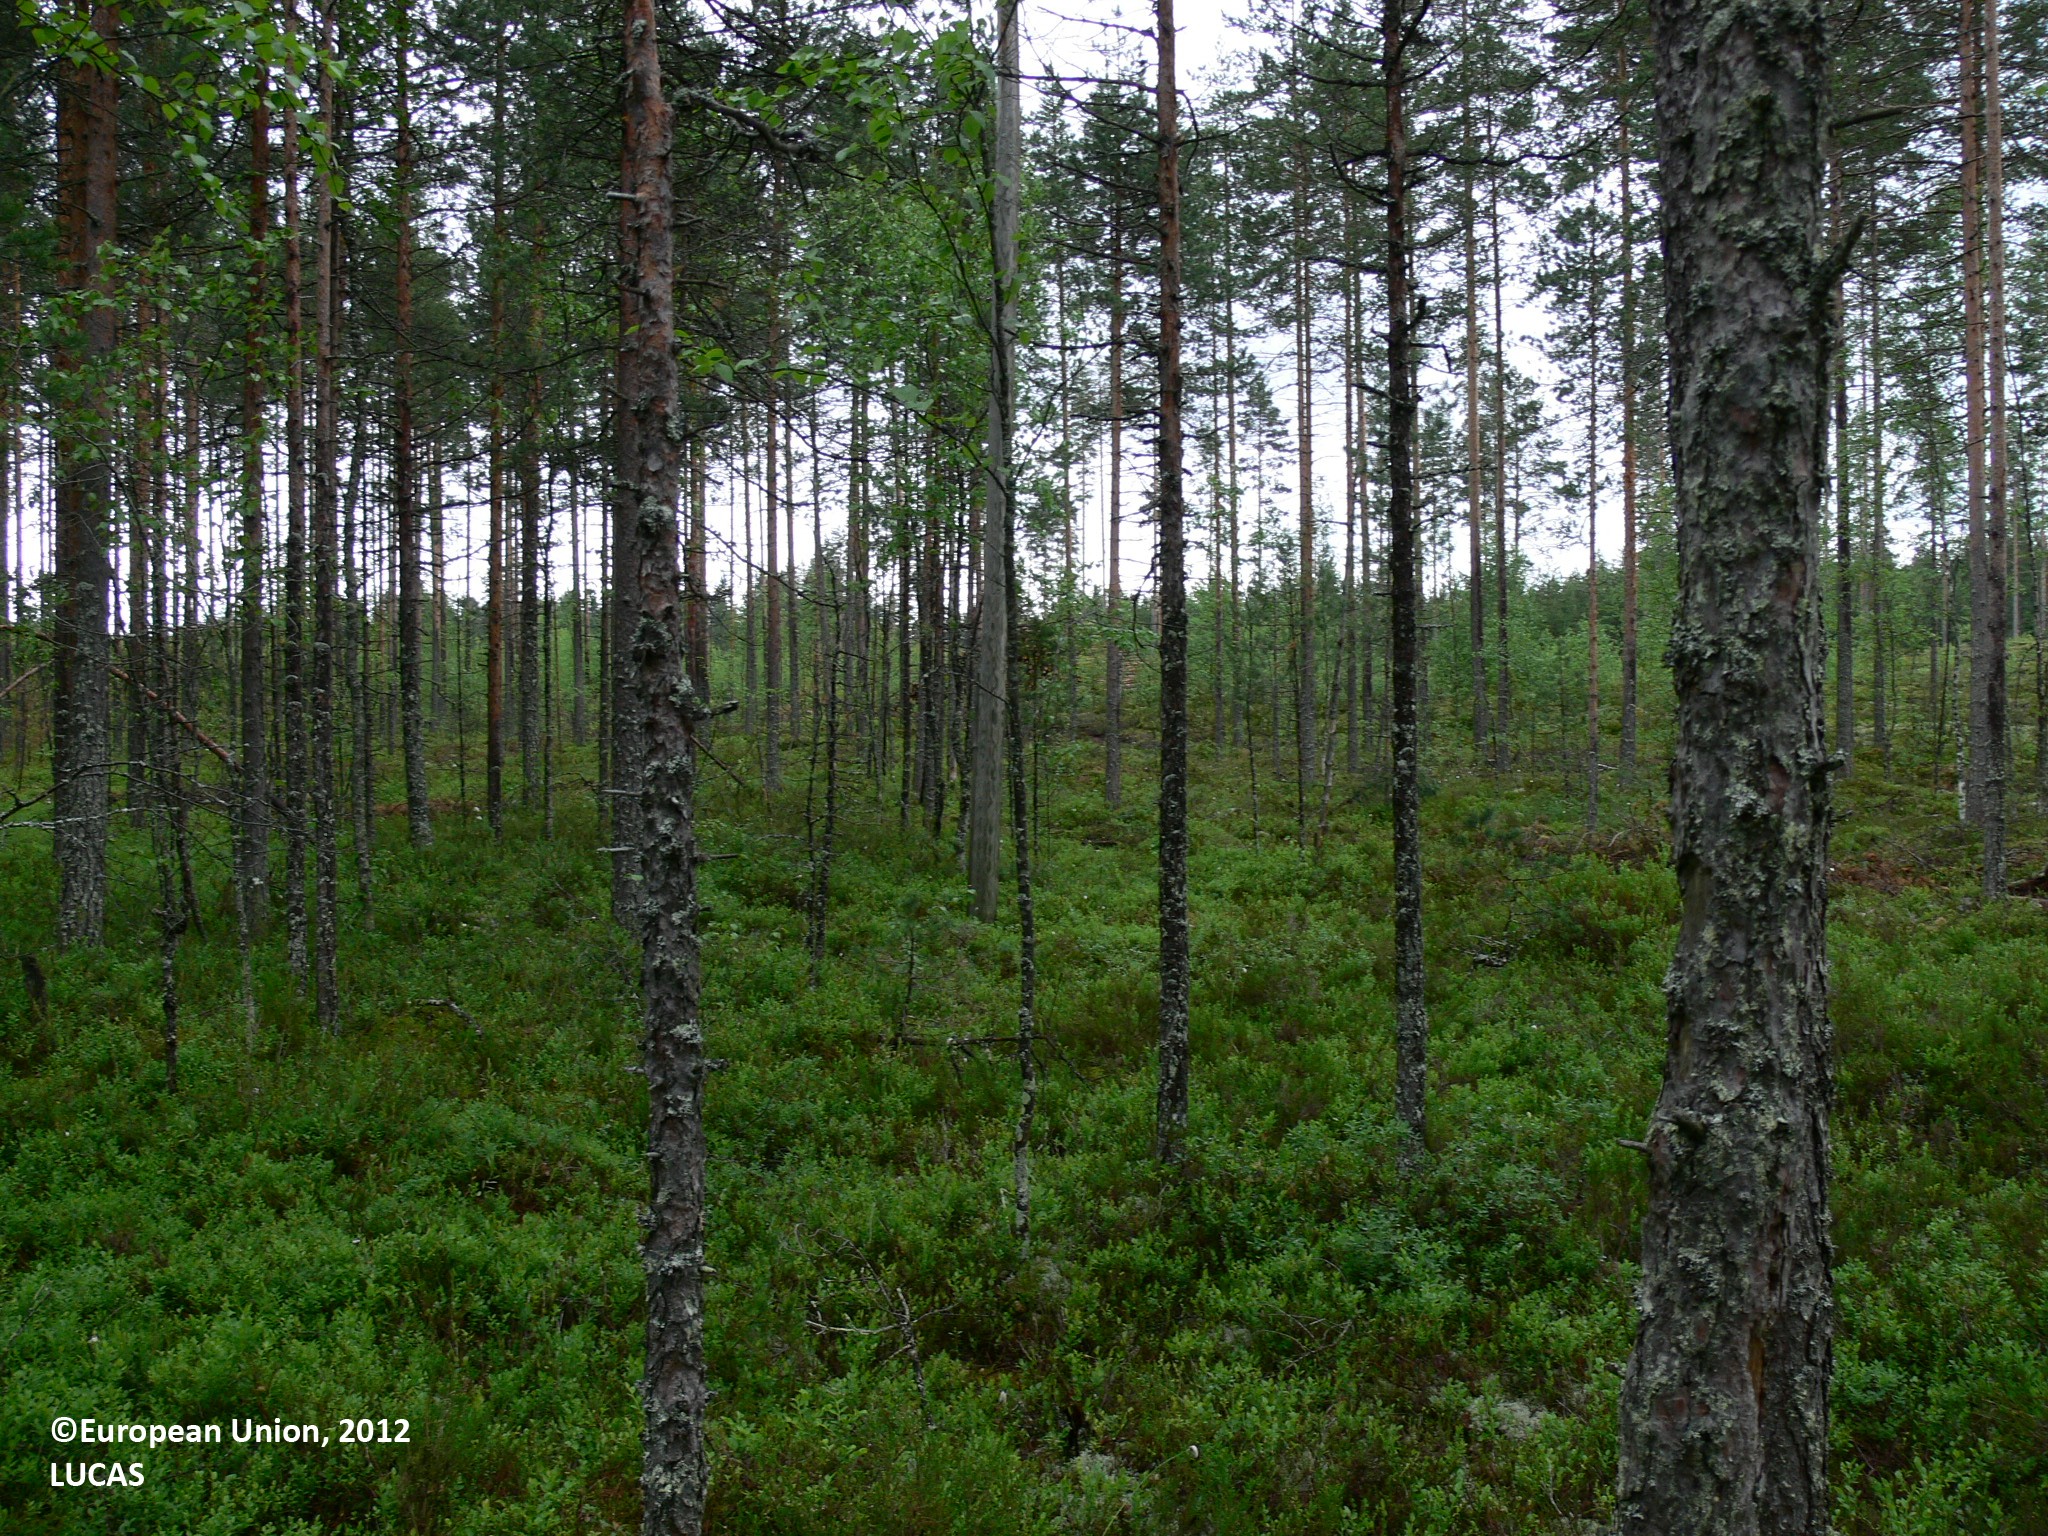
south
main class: Woodland
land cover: Pine dominated coniferous woodland
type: boreal forest
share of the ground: > 75 %
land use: Forestry
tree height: > 5 m
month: June
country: FI
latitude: 62.6468
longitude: 29.6144
